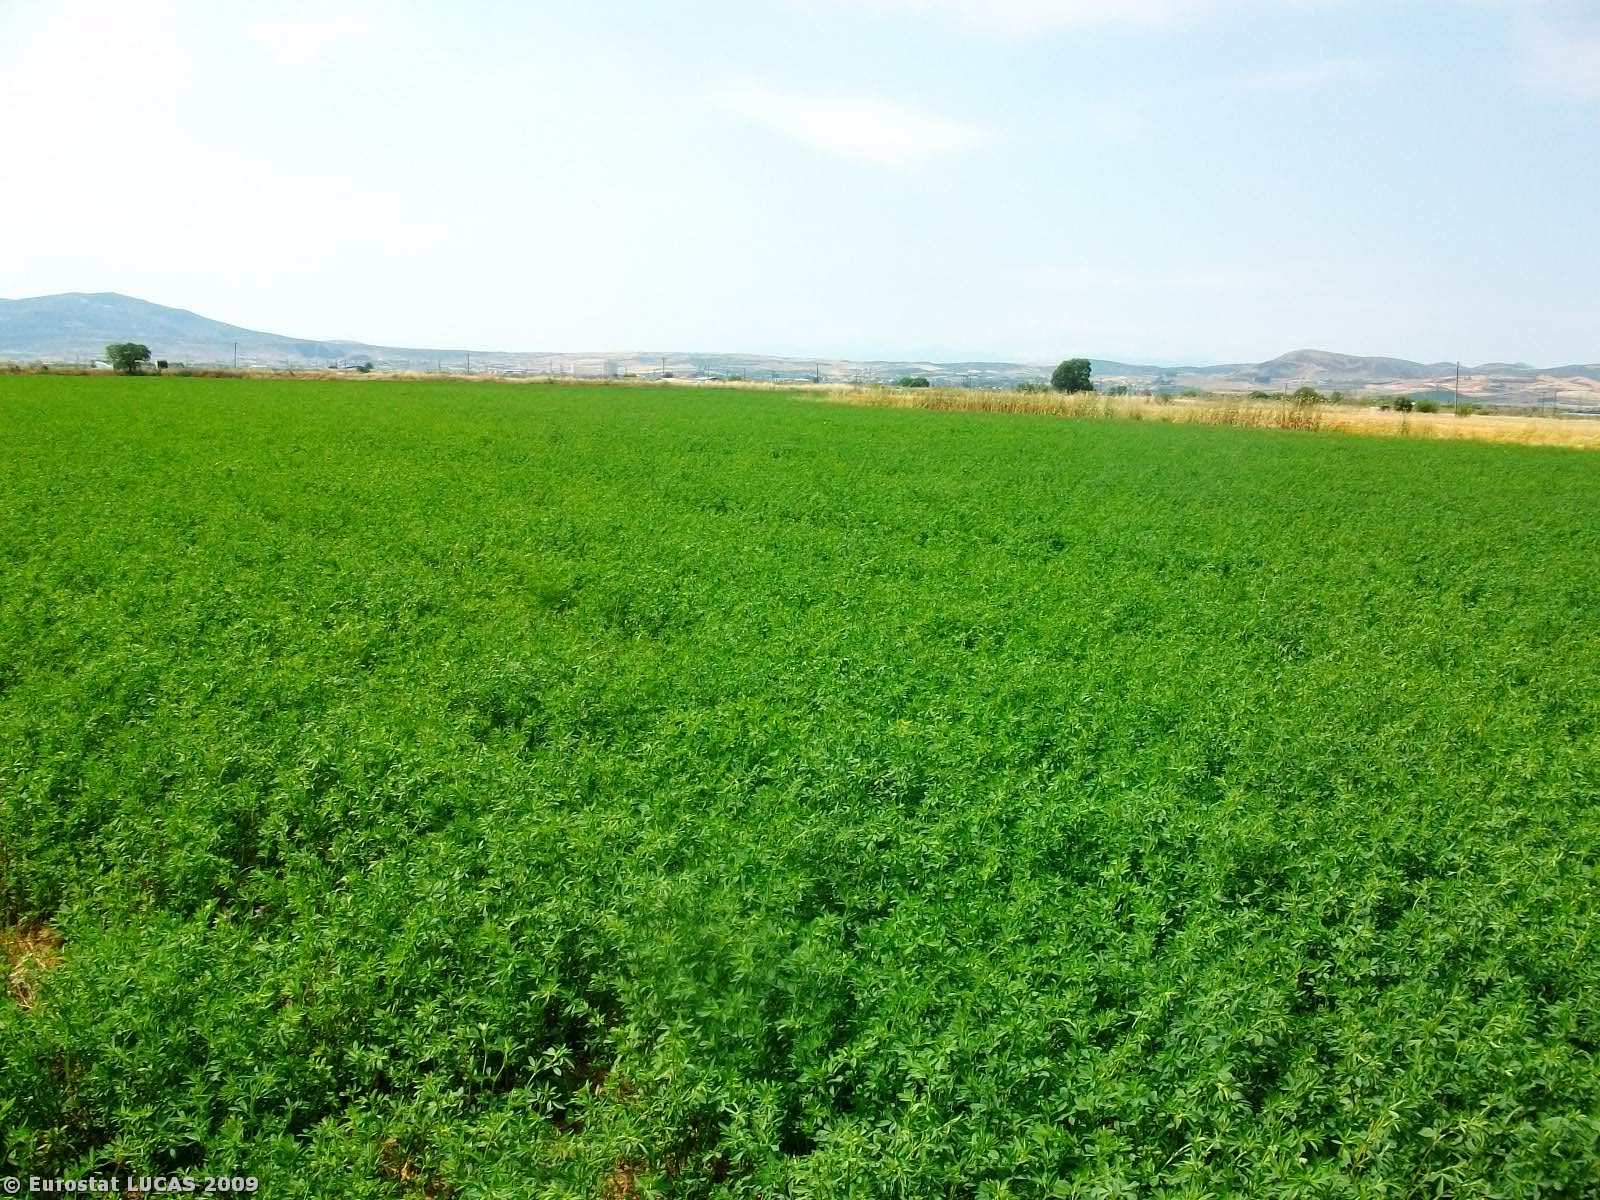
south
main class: Cropland
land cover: Lucerne
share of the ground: > 75 %
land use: Agriculture (excluding fallow land and kitchen gardens)
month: May
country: GR
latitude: 39.4307
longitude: 22.7580
